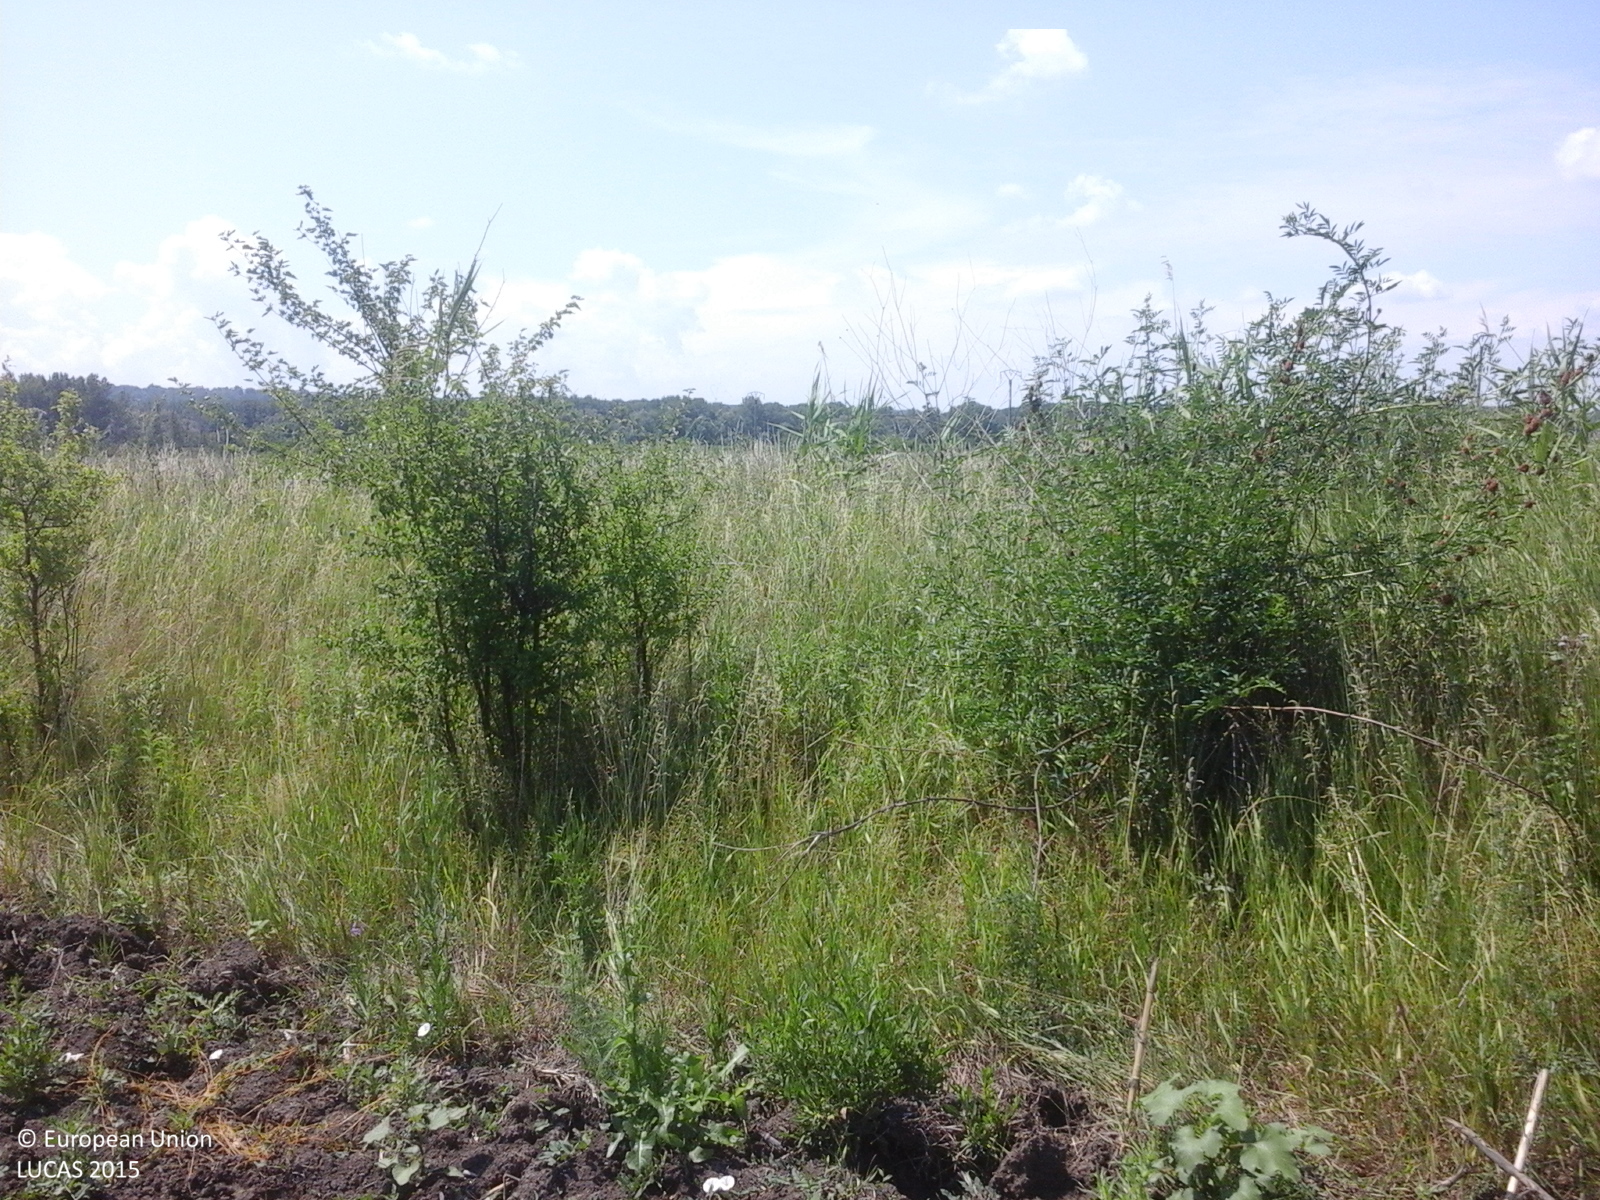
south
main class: Cropland
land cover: Soya
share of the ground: < 10 %
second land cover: Spontaneously vegetated surfaces
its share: 25 - 50 %
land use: Agriculture (excluding fallow land and kitchen gardens)
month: June
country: RO
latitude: 44.0674
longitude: 26.6064
